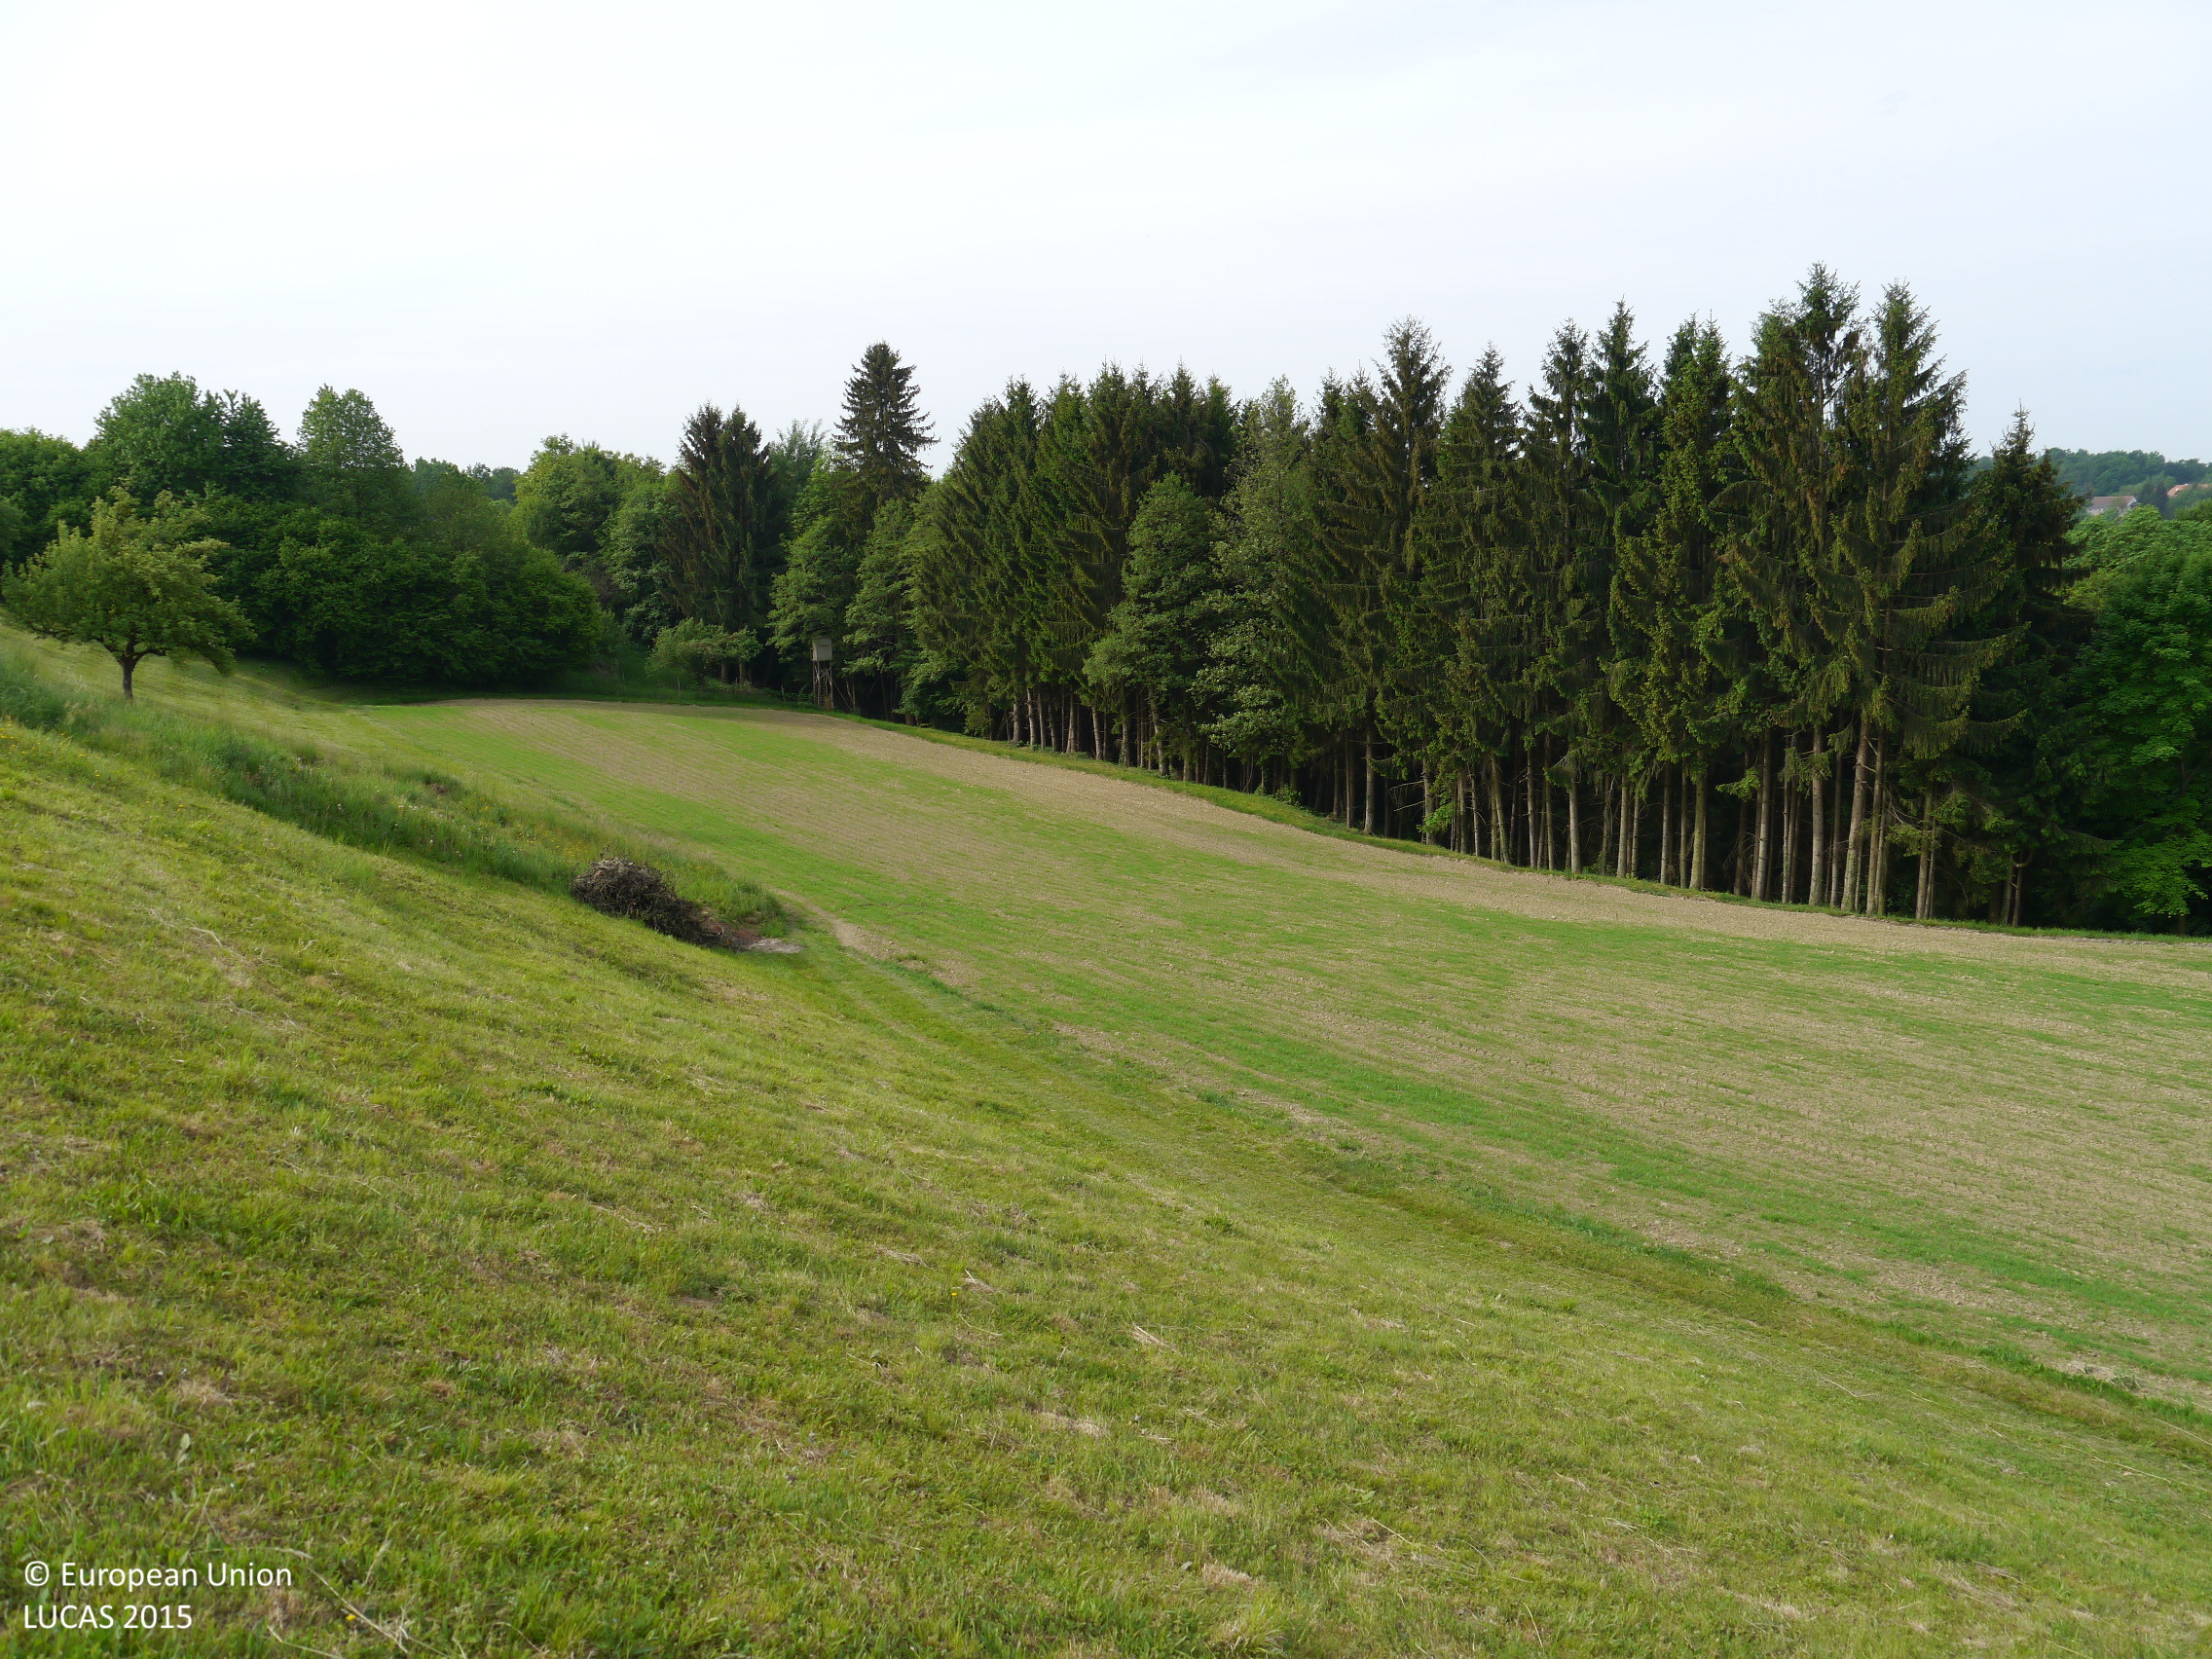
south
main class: Grassland
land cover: Grassland without tree/shrub cover
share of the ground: > 75 %
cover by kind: herbaceous plants 100 %
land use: Agriculture (excluding fallow land and kitchen gardens)
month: May
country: AT
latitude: 46.9772
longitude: 15.6659
